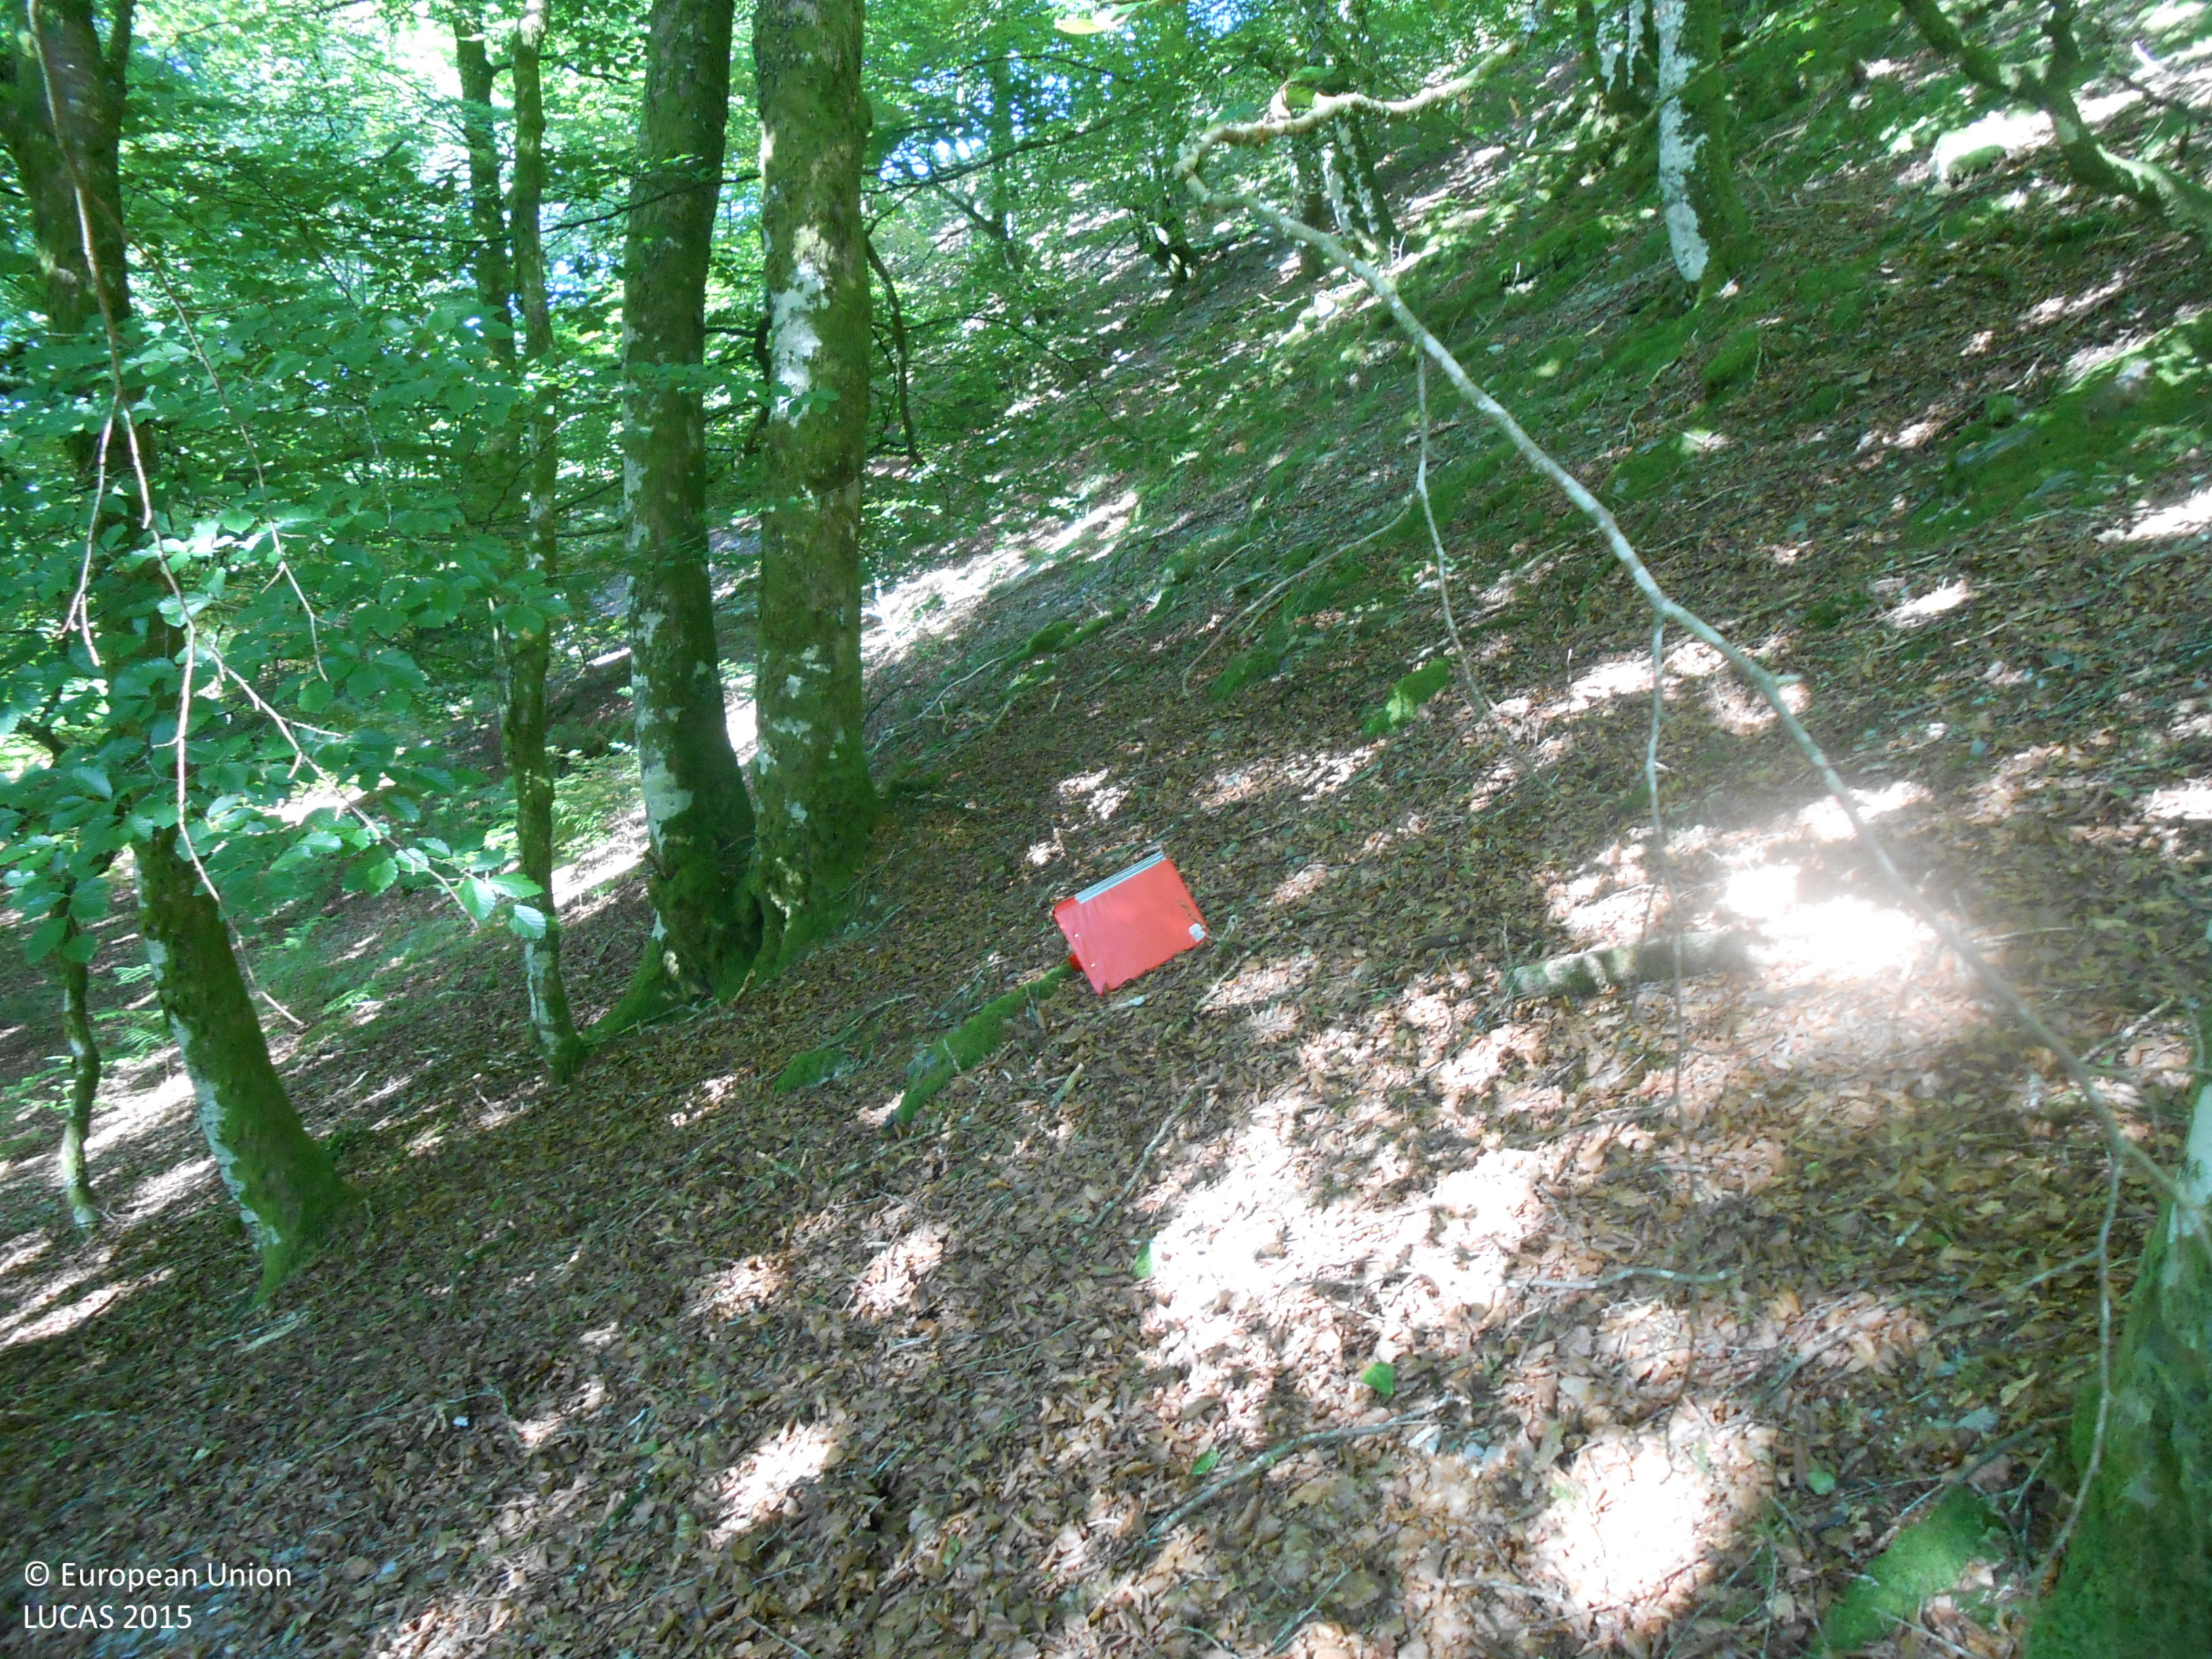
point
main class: Woodland
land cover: Broadleaved woodland
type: beech forest
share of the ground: > 75 %
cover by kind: broadleaved forest trees 100 %
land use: Forestry
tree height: > 5 m
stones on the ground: 25 - 50 %
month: June
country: ES
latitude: 43.1125
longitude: -1.7793
